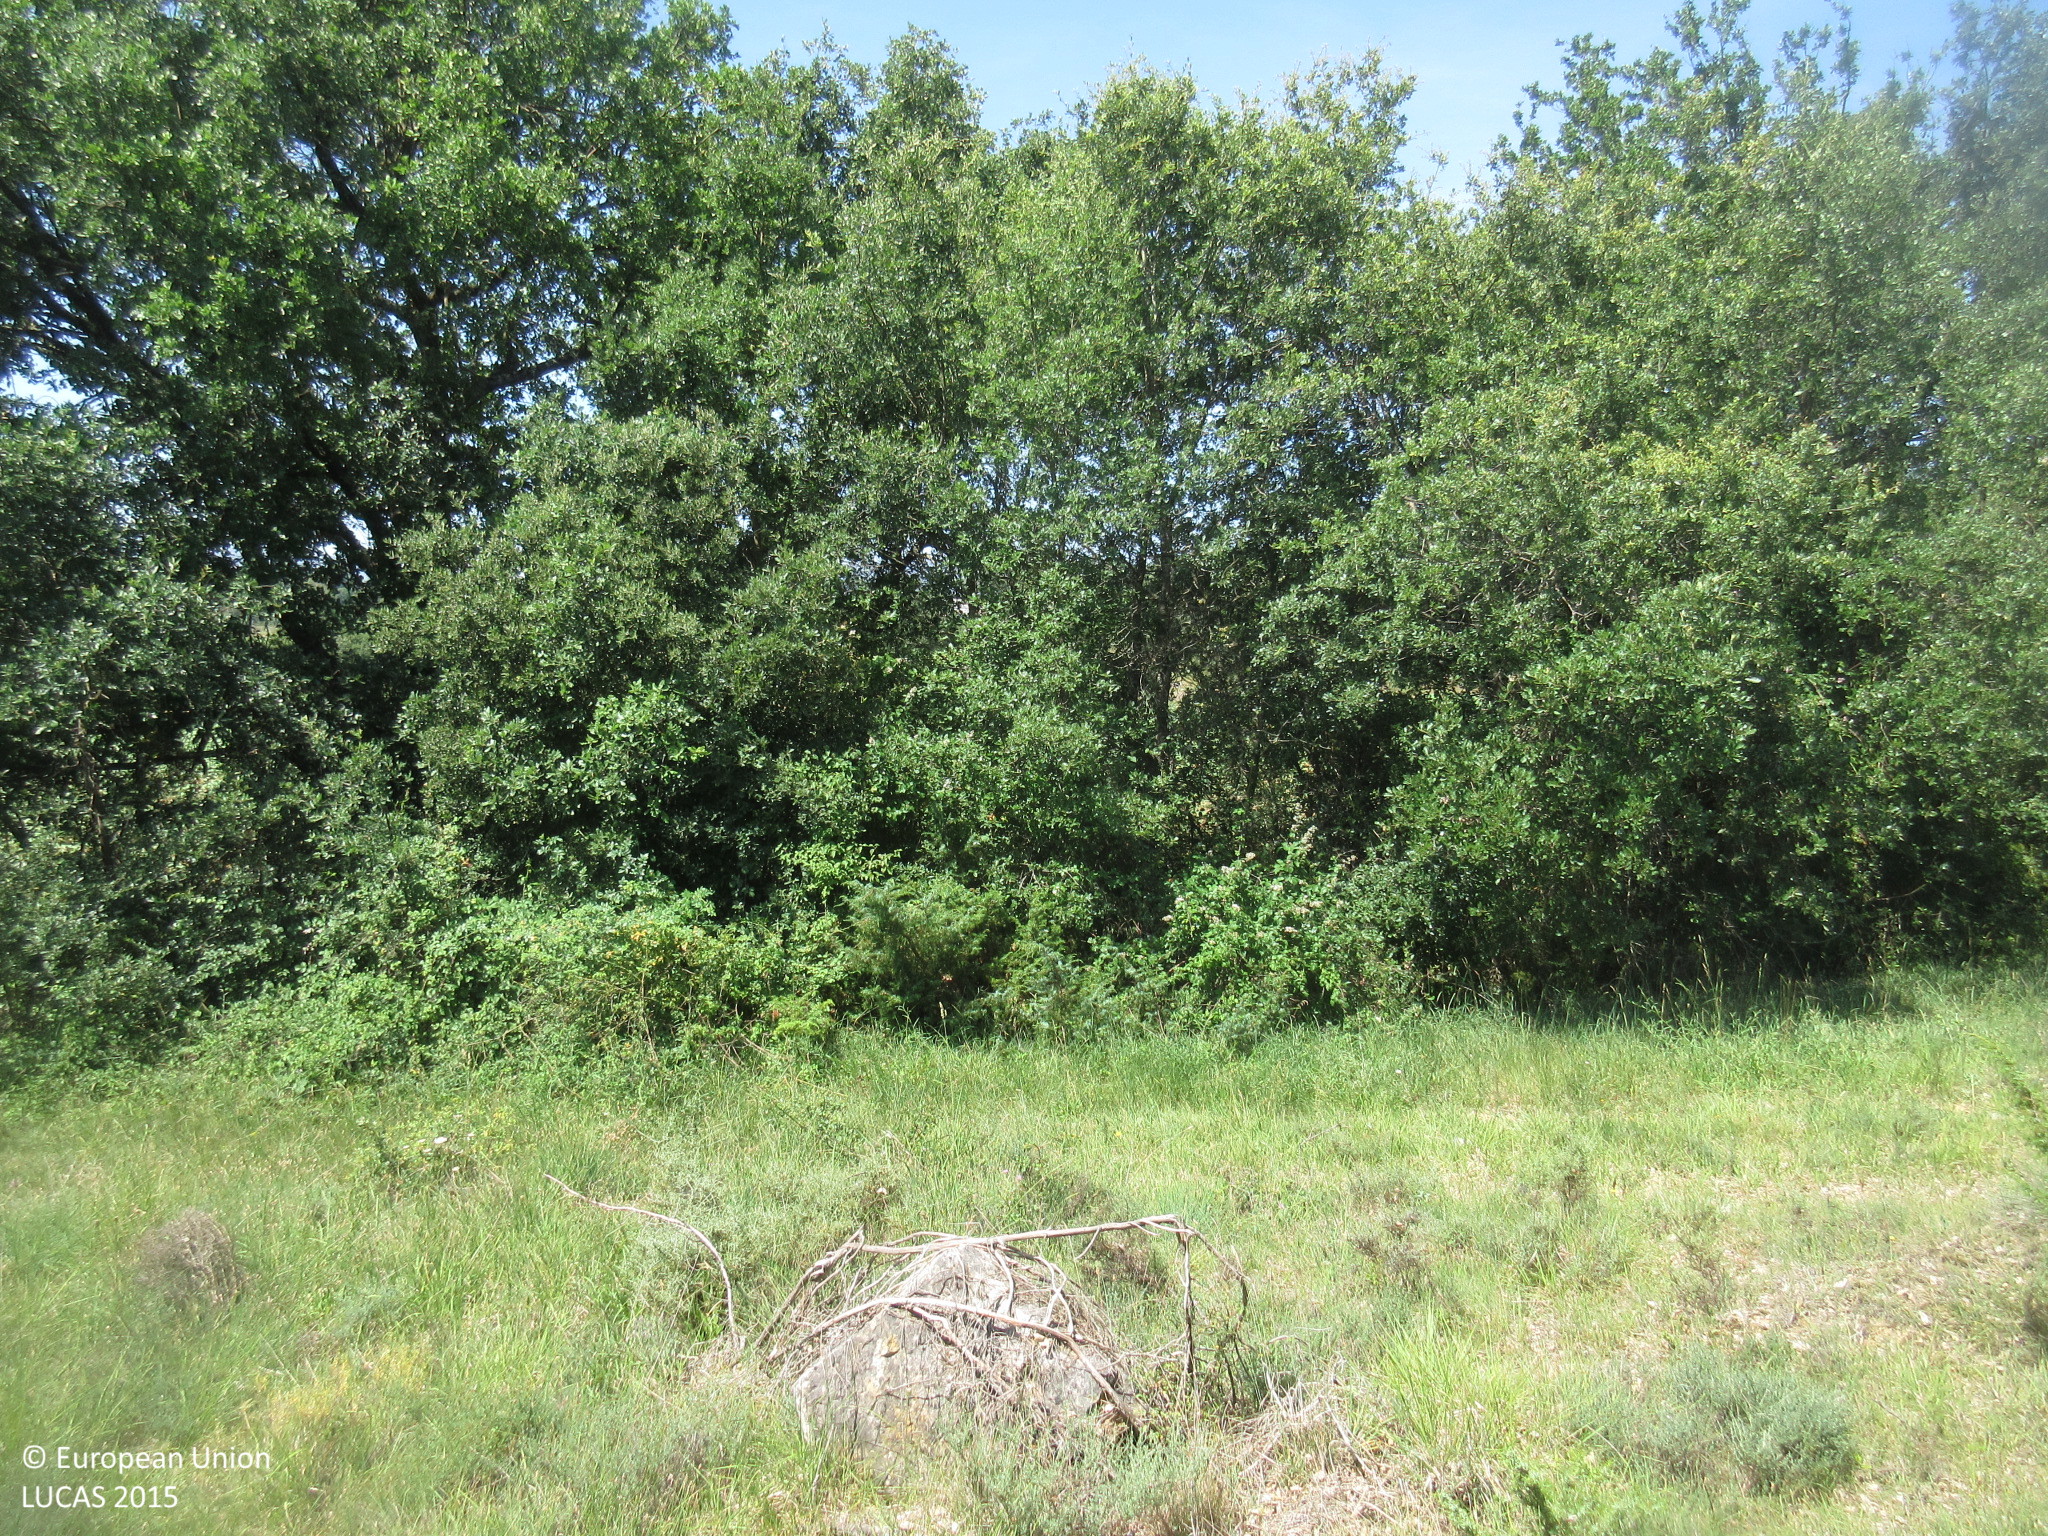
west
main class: Woodland
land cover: Broadleaved woodland
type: broadleaved evergreen forest
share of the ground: 50 - 75 %
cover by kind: broadleaved forest trees 70 %, shrubs 15 %, herbaceous plants 15 %
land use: Semi-natural and natural areas not in use
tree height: < 5 m
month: July
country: ES
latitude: 42.9475
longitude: -3.5341
